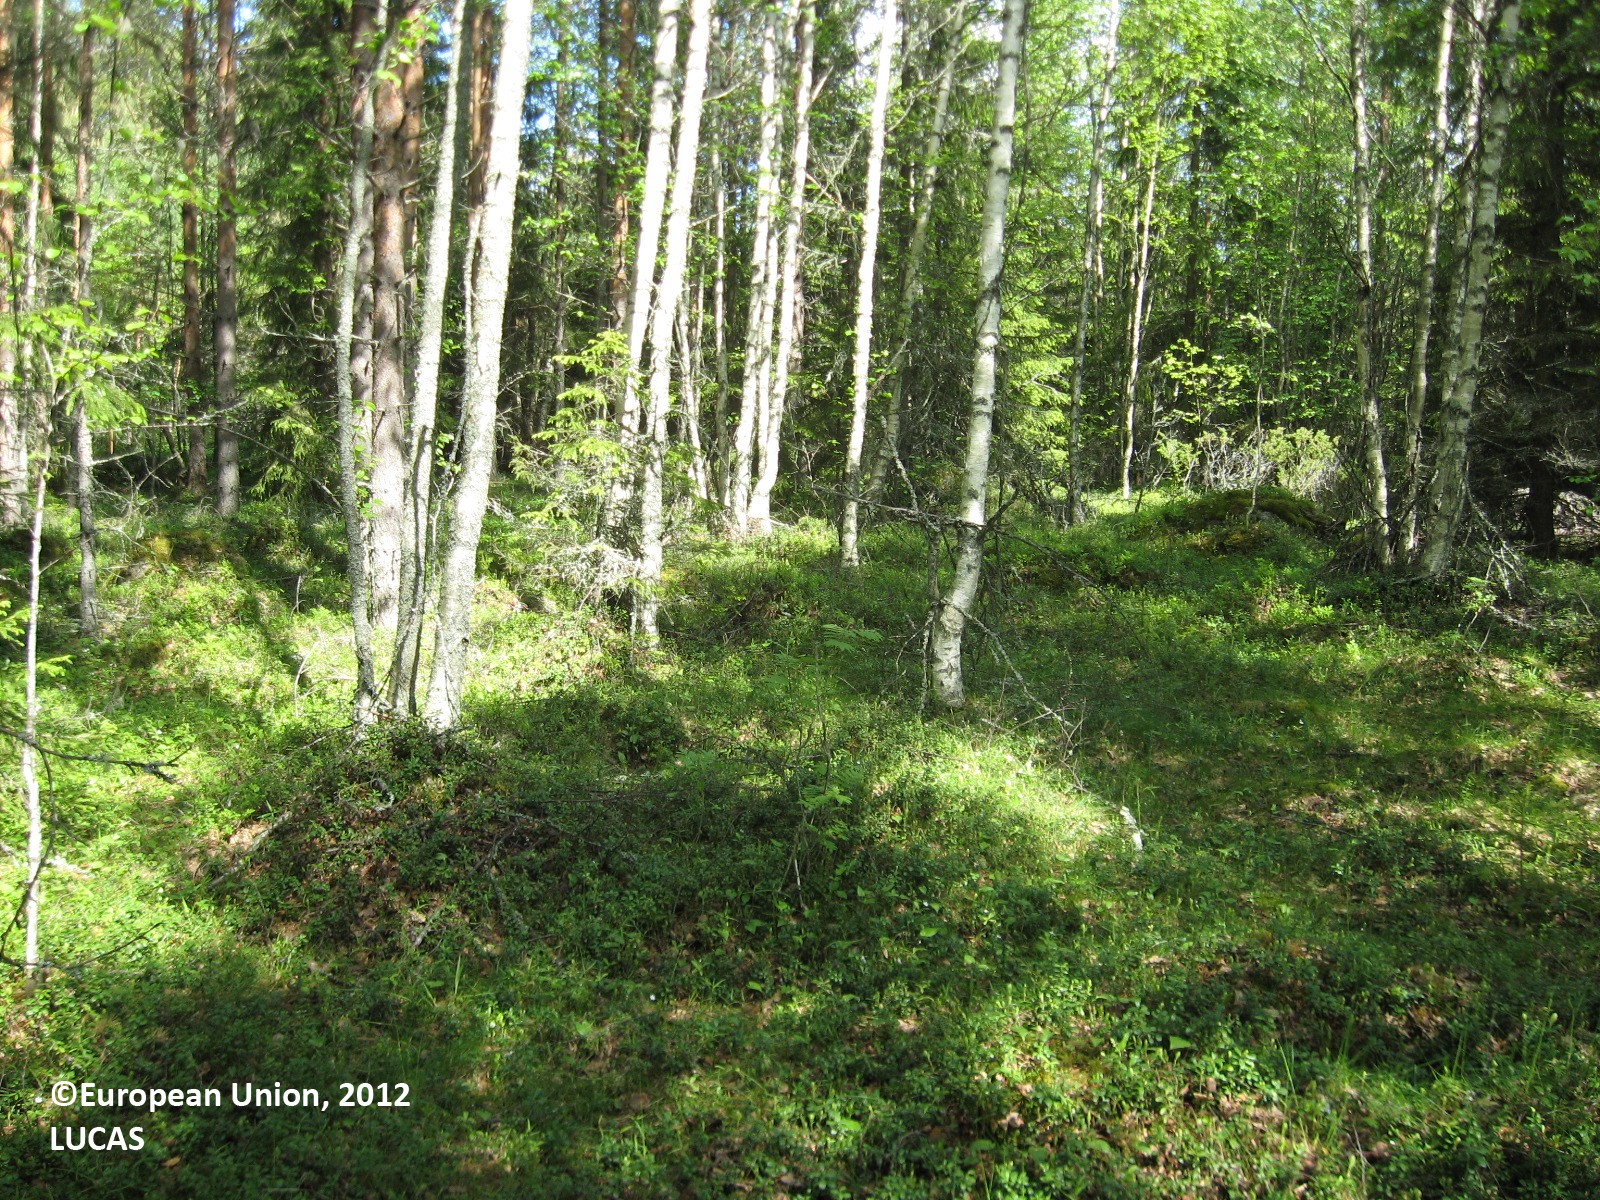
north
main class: Woodland
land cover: Broadleaved woodland
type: boreal forest
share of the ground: > 75 %
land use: Forestry
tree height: > 5 m
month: June
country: FI
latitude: 63.1503
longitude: 22.0512
